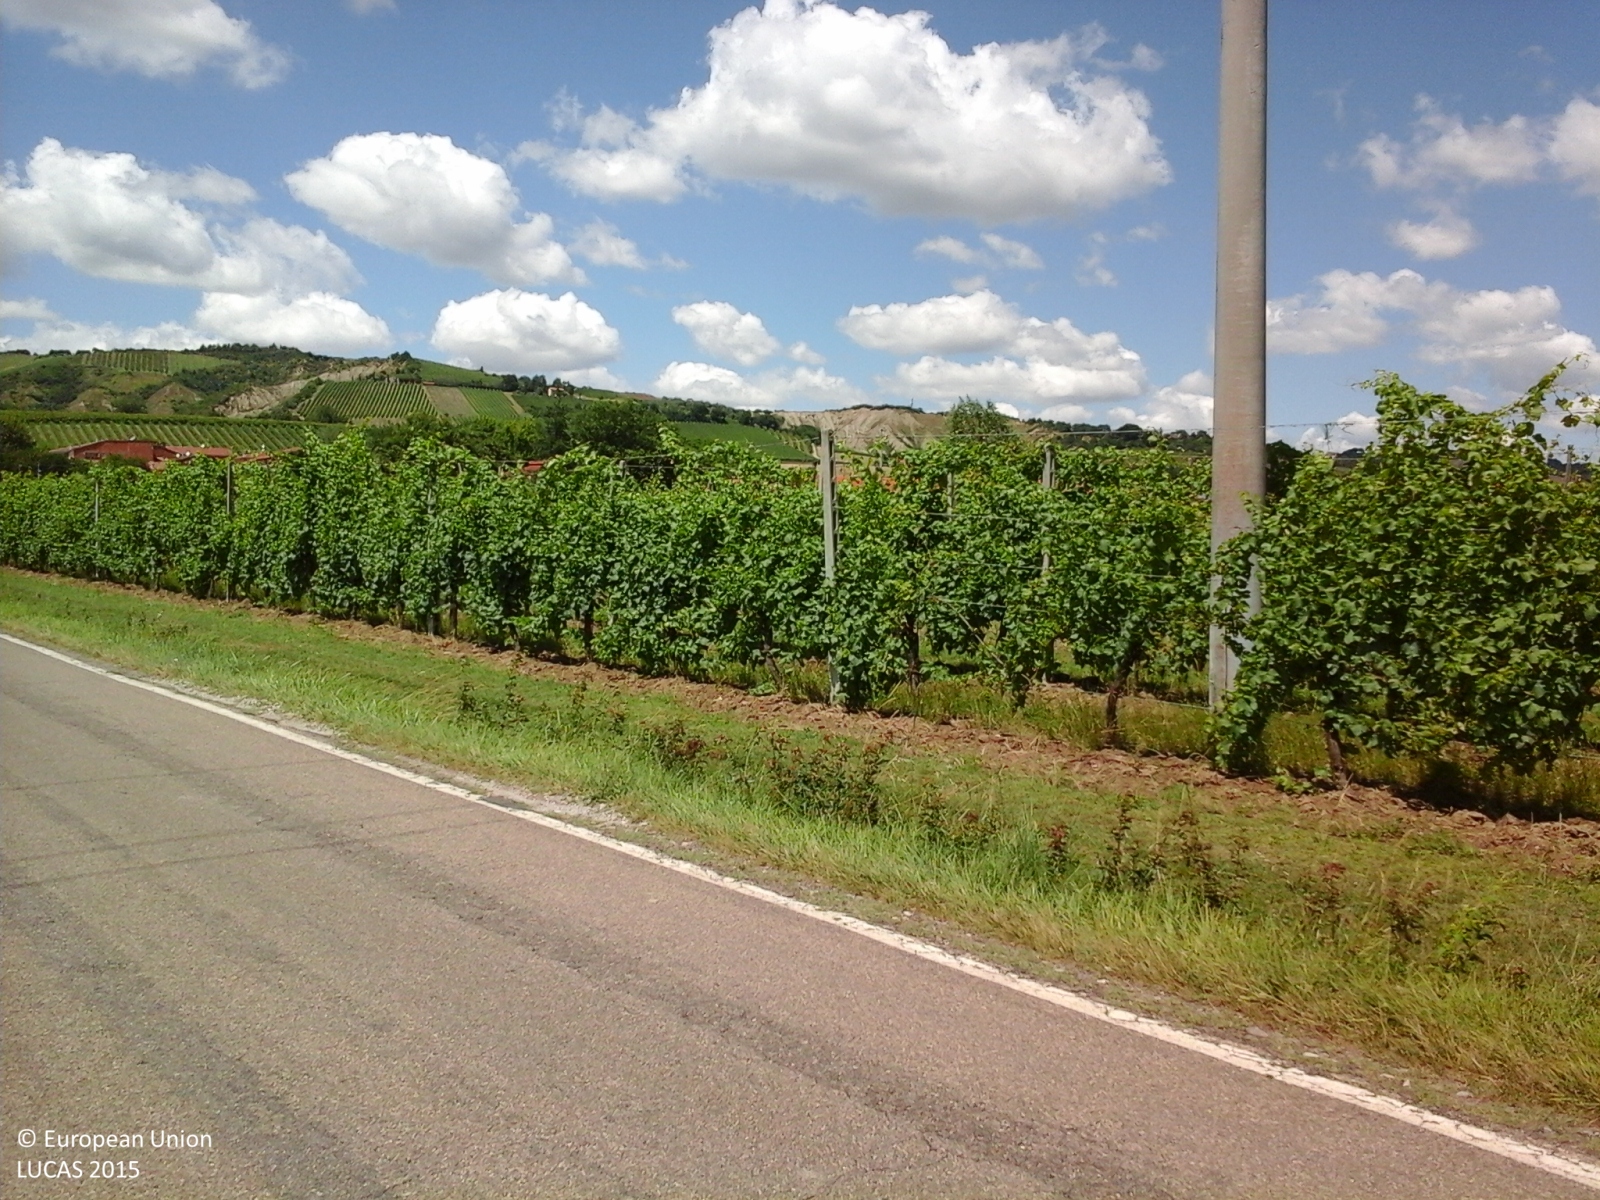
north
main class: Artificial land
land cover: Non built-up linear features
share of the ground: > 75 %
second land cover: Grassland without tree/shrub cover
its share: > 75 %
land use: Road transport
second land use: Agriculture (excluding fallow land and kitchen gardens)
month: June
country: IT
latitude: 44.3015
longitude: 11.6383
